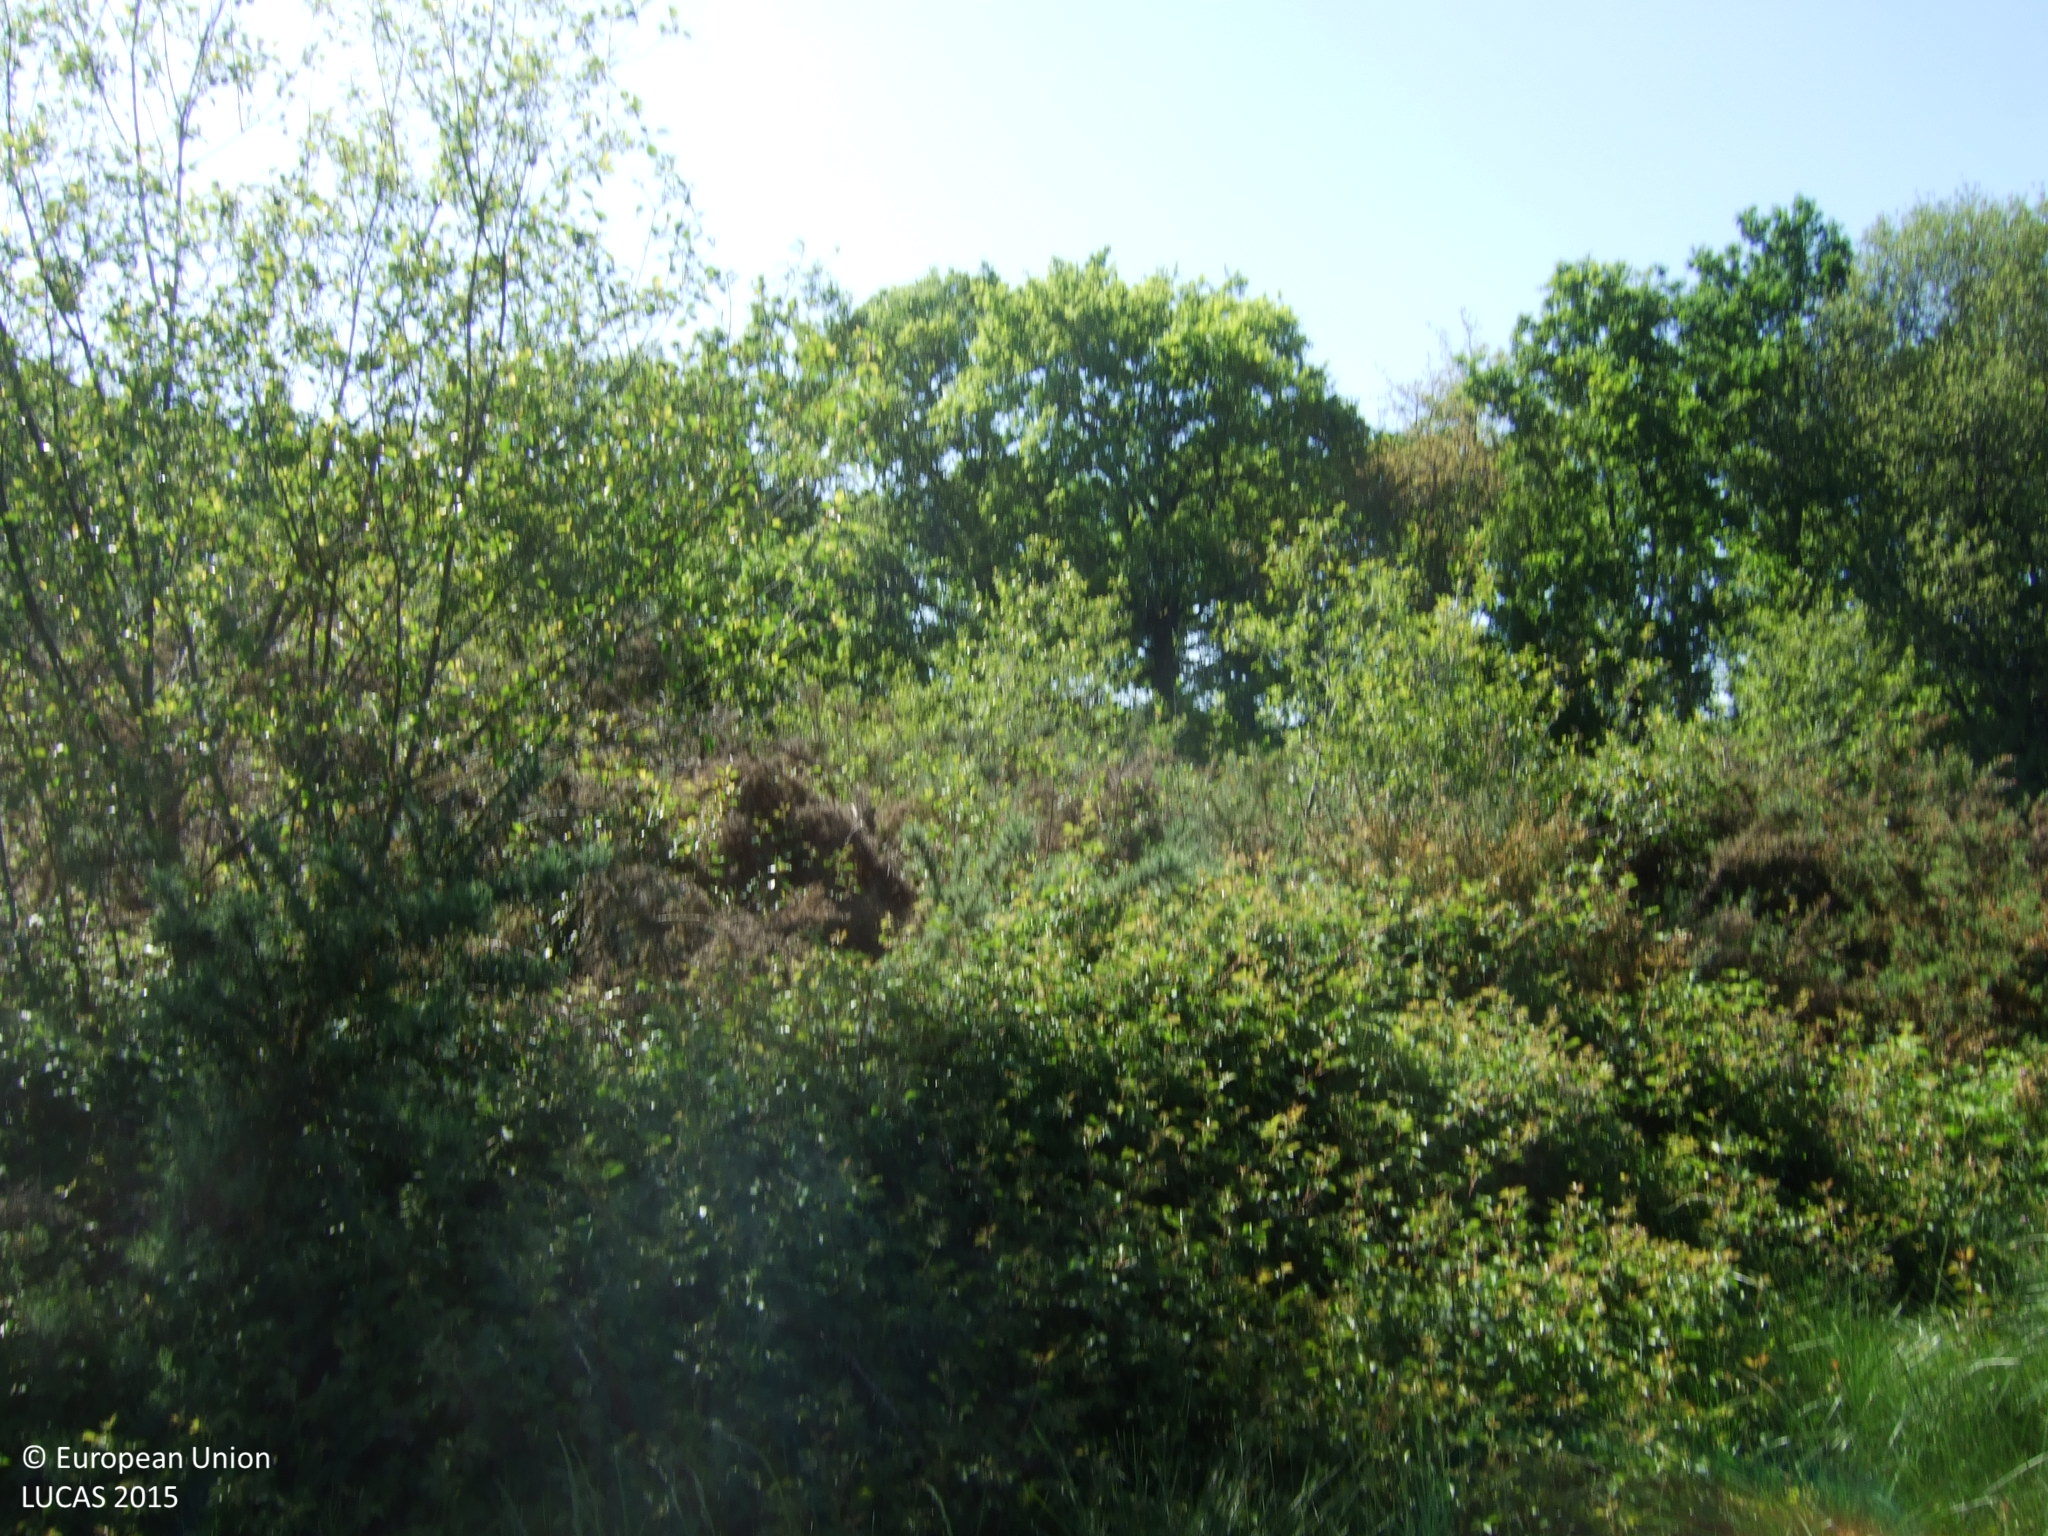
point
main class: Shrubland
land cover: Shrubland with sparse tree cover
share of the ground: > 75 %
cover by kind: shrubs 95 %, broadleaved forest trees 5 %
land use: Abandoned areas
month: May
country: ES
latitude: 43.2007
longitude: -7.4920
